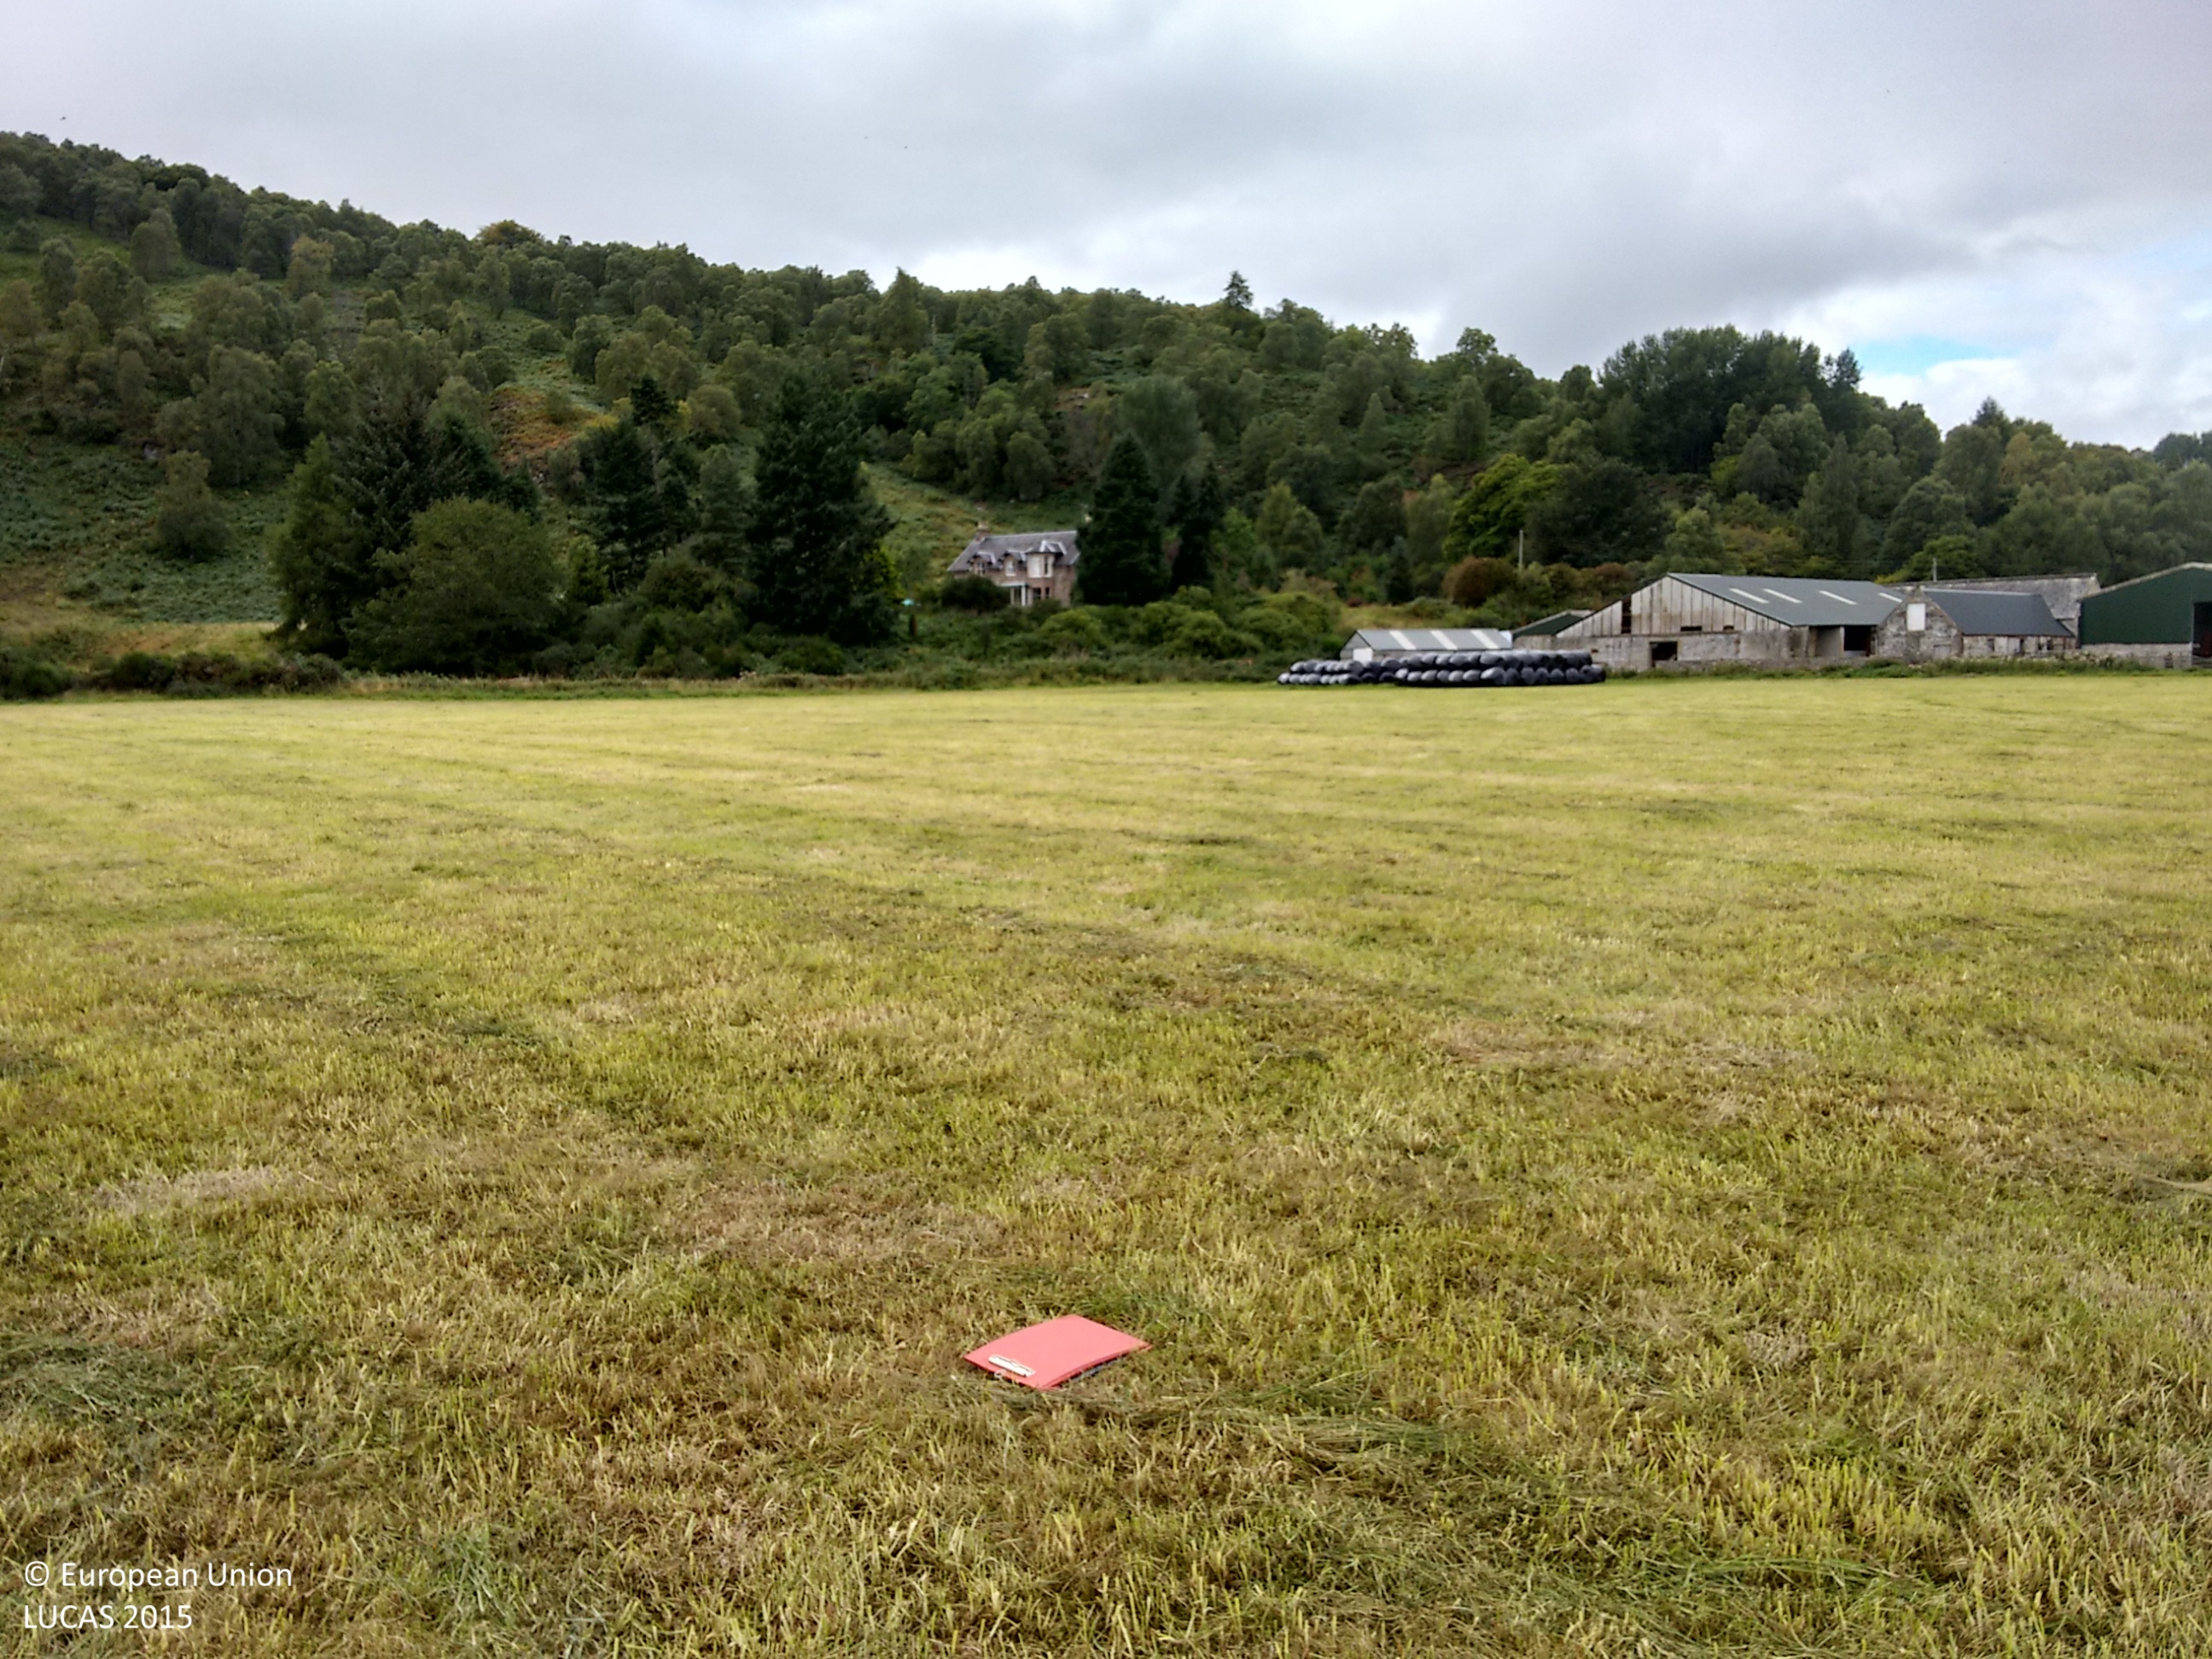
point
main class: Grassland
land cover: Grassland without tree/shrub cover
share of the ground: > 75 %
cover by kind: herbaceous plants 100 %
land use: Agriculture (excluding fallow land and kitchen gardens)
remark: Harvested field
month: September
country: GB
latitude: 57.5641
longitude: -4.5859
